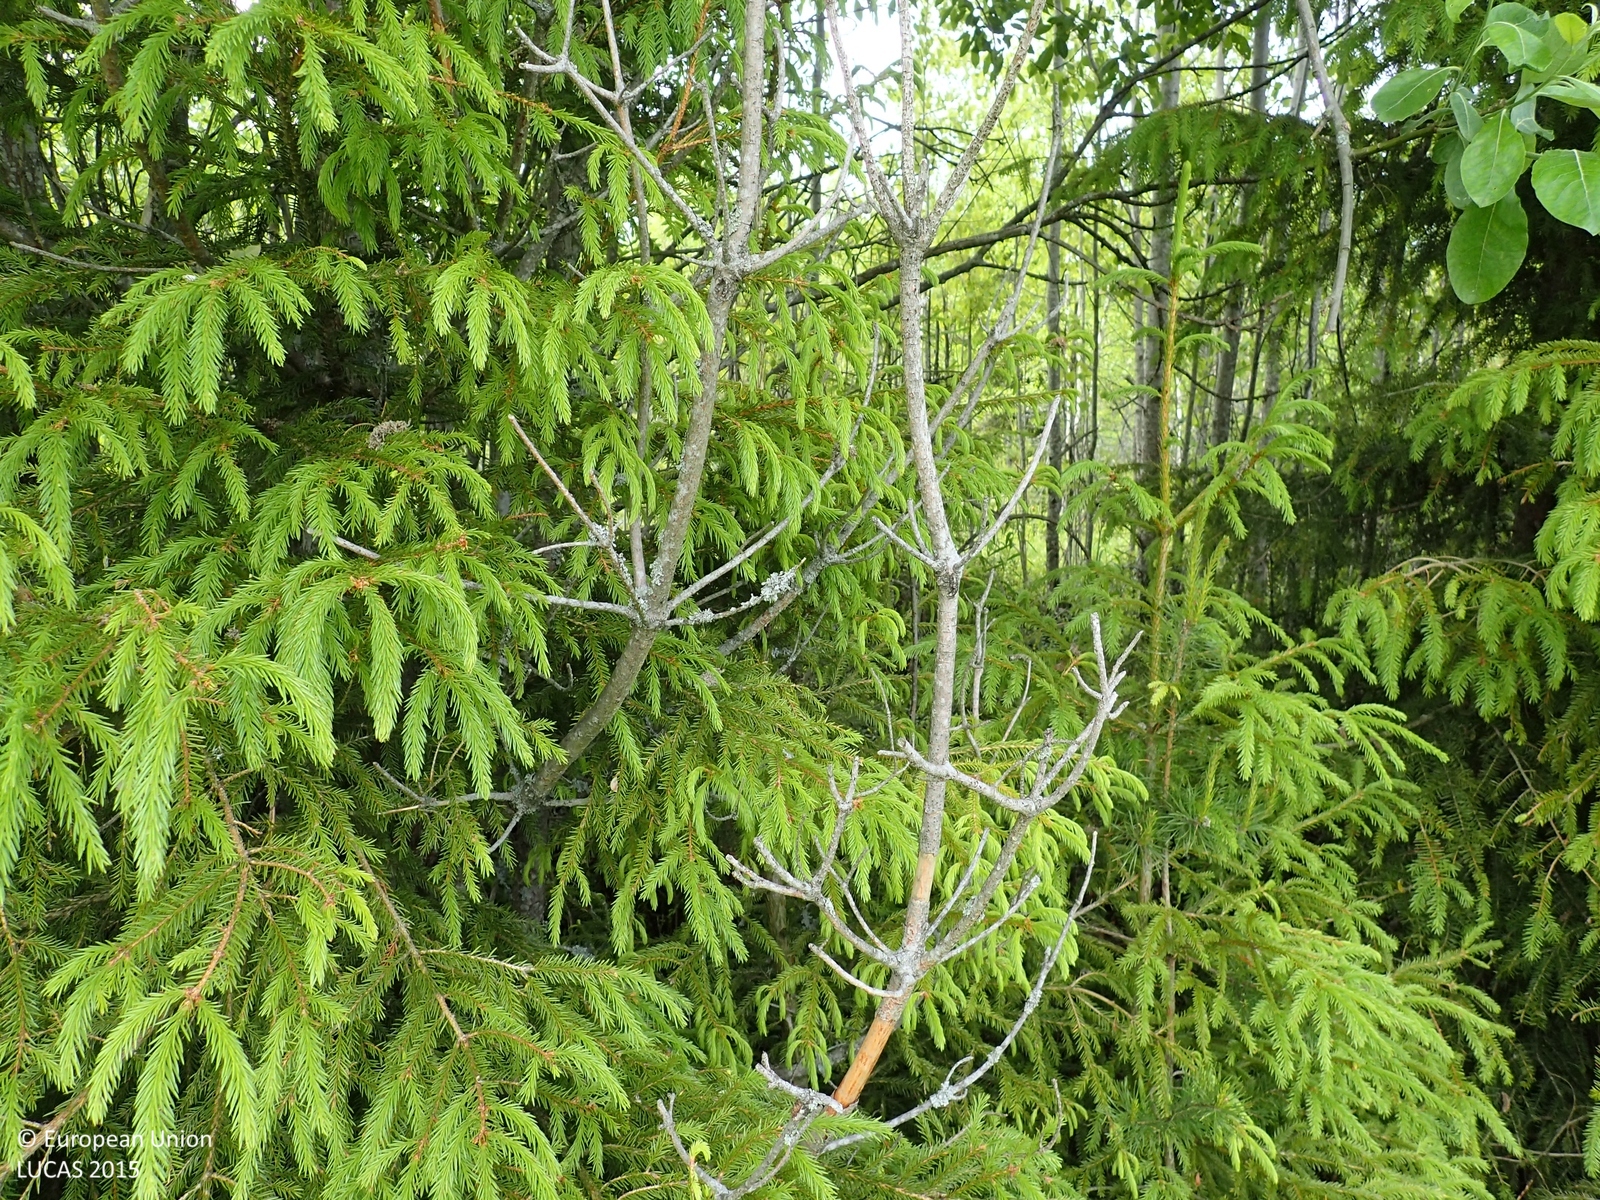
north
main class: Cropland
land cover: Barley
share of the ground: > 75 %
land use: Agriculture (excluding fallow land and kitchen gardens)
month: June
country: FI
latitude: 62.3381
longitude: 21.6894
